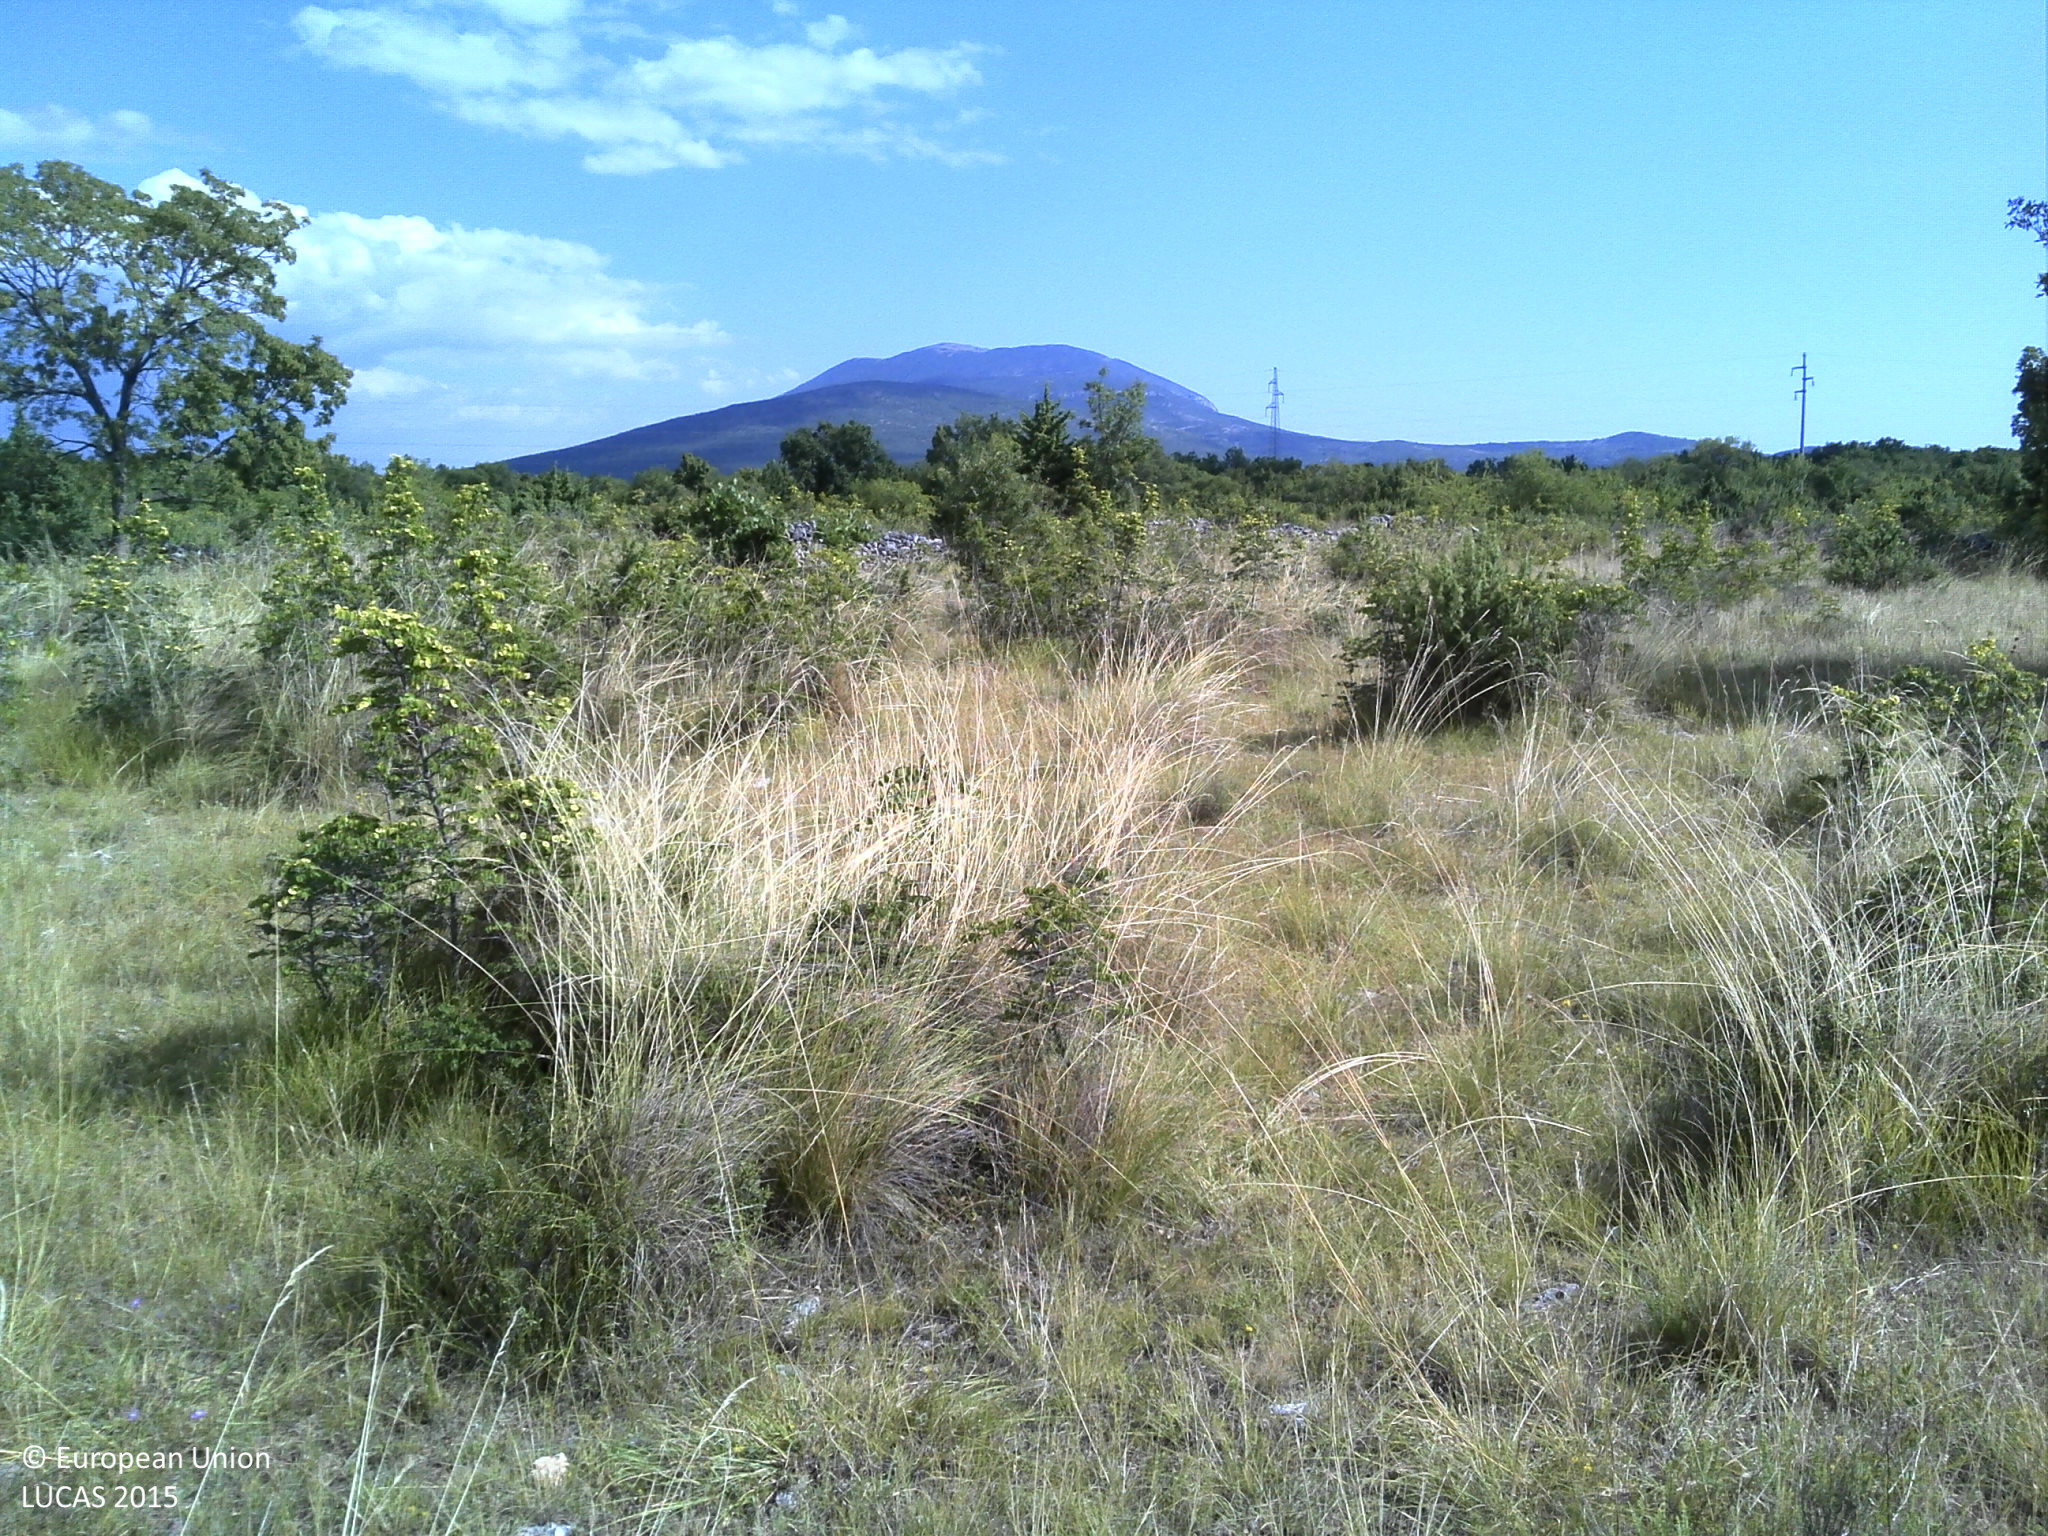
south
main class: Shrubland
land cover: Shrubland with sparse tree cover
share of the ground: 50 - 75 %
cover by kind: shrubs 55 %, herbaceous plants 35 %, broadleaved forest trees 5 %, consolidated bare surface 5 %
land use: Semi-natural and natural areas not in use
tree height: < 5 m
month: July
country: HR
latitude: 44.0073
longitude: 16.1162
